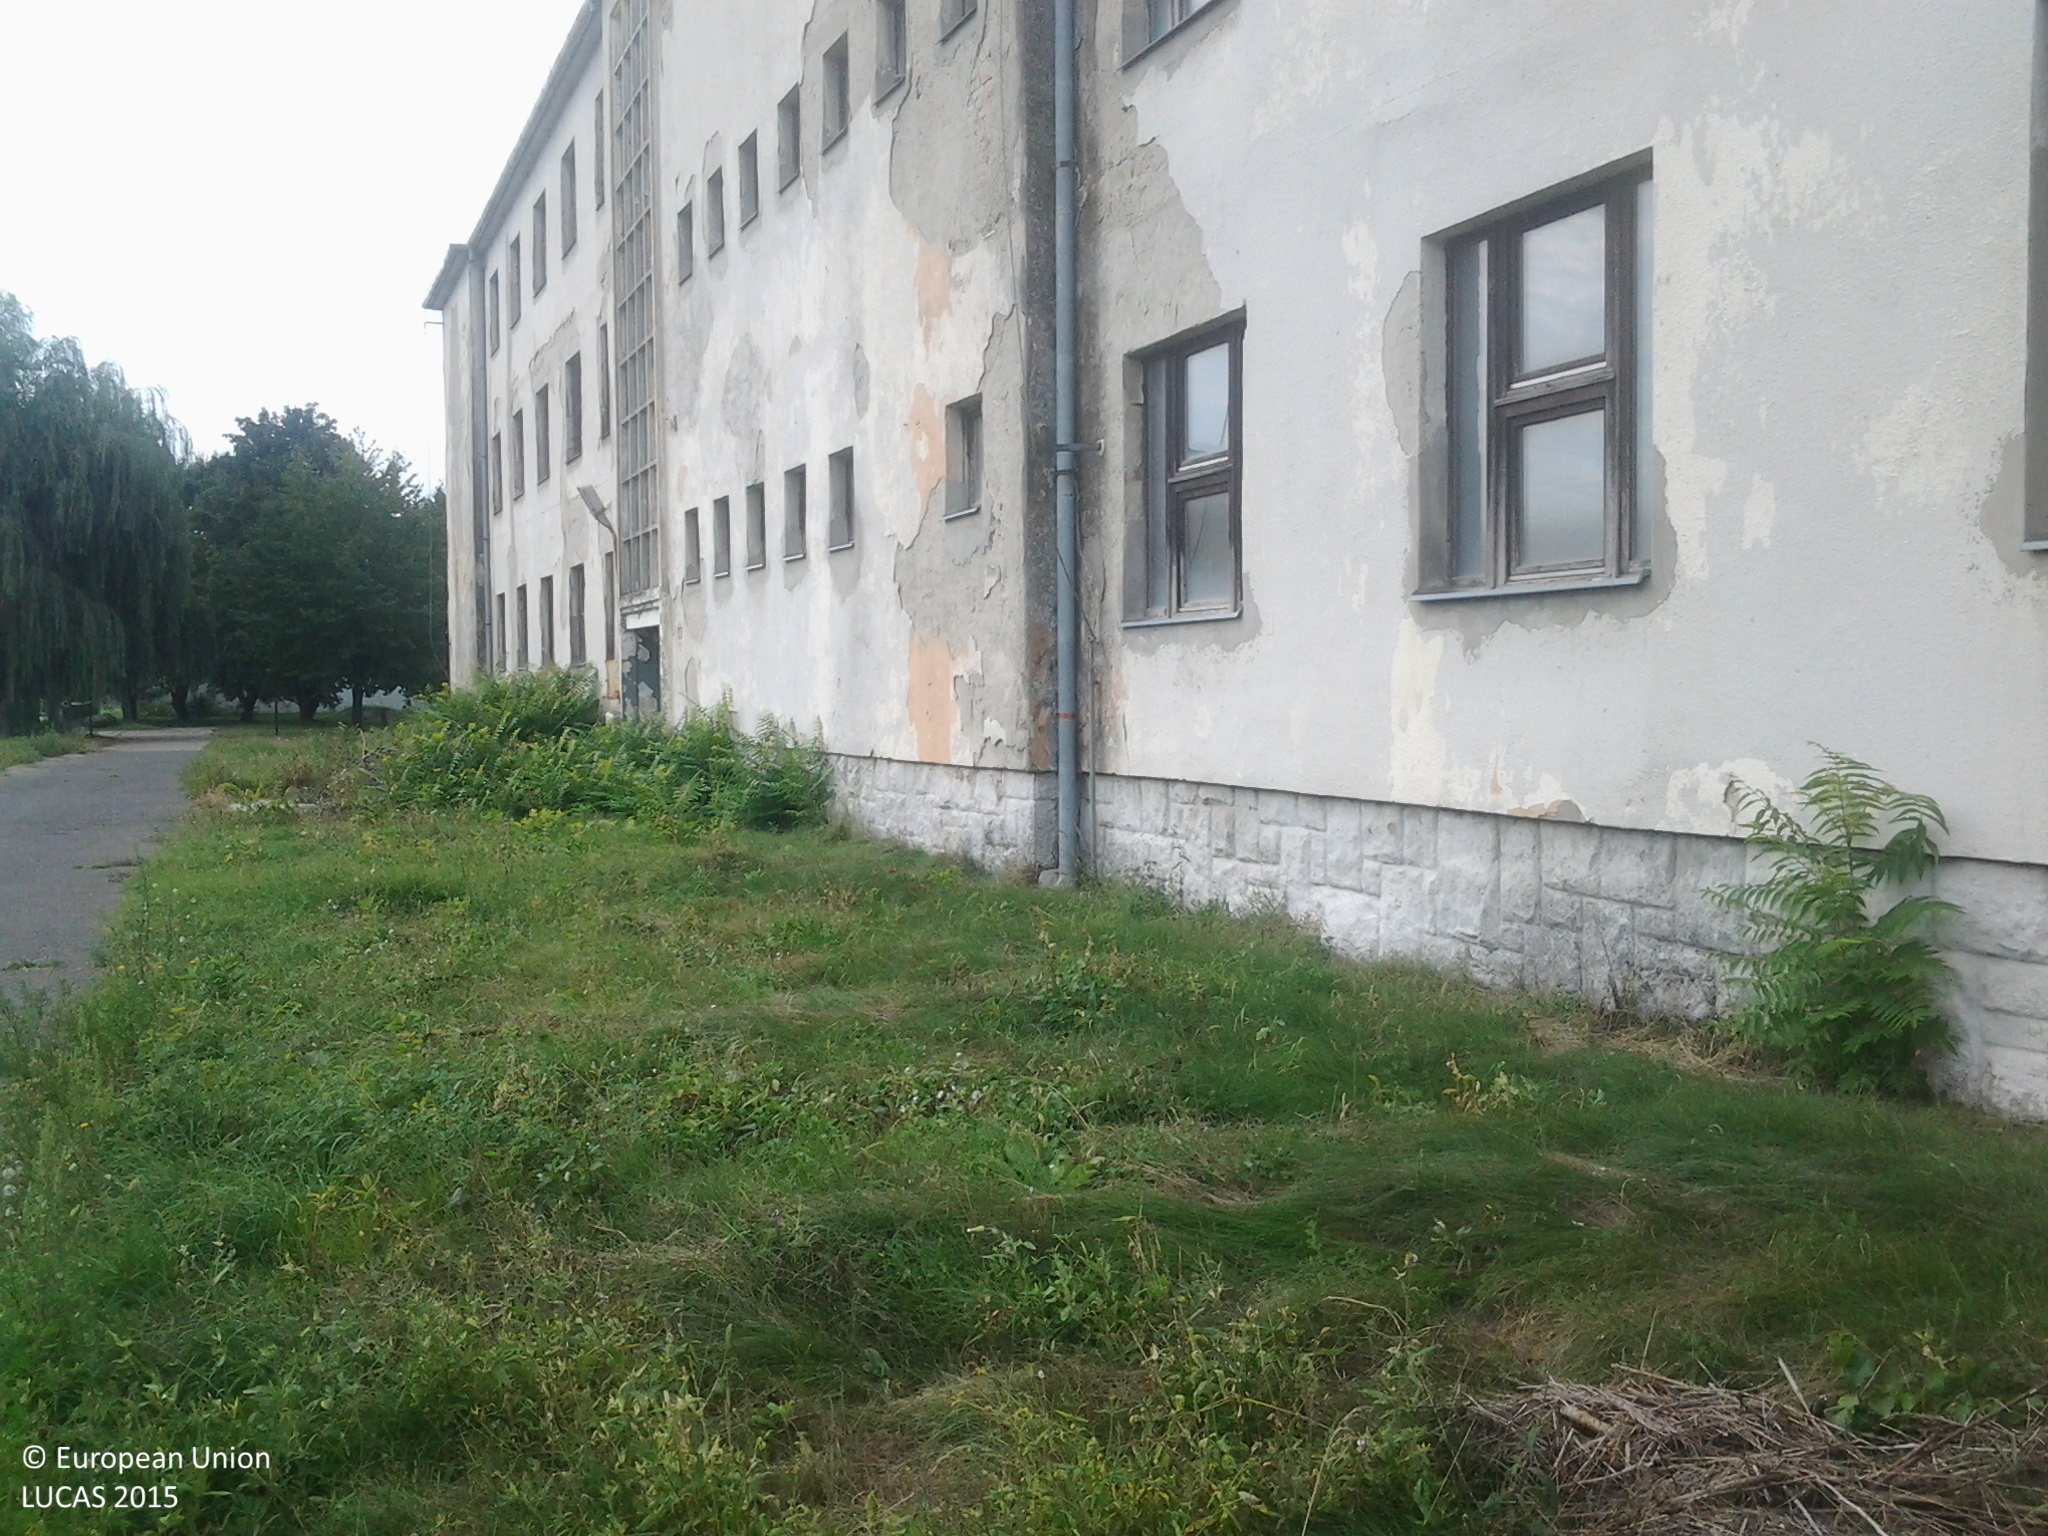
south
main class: Grassland
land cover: Spontaneously vegetated surfaces
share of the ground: > 75 %
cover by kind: herbaceous plants 100 %
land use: Residential
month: August
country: HU
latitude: 46.1558
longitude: 18.9596
